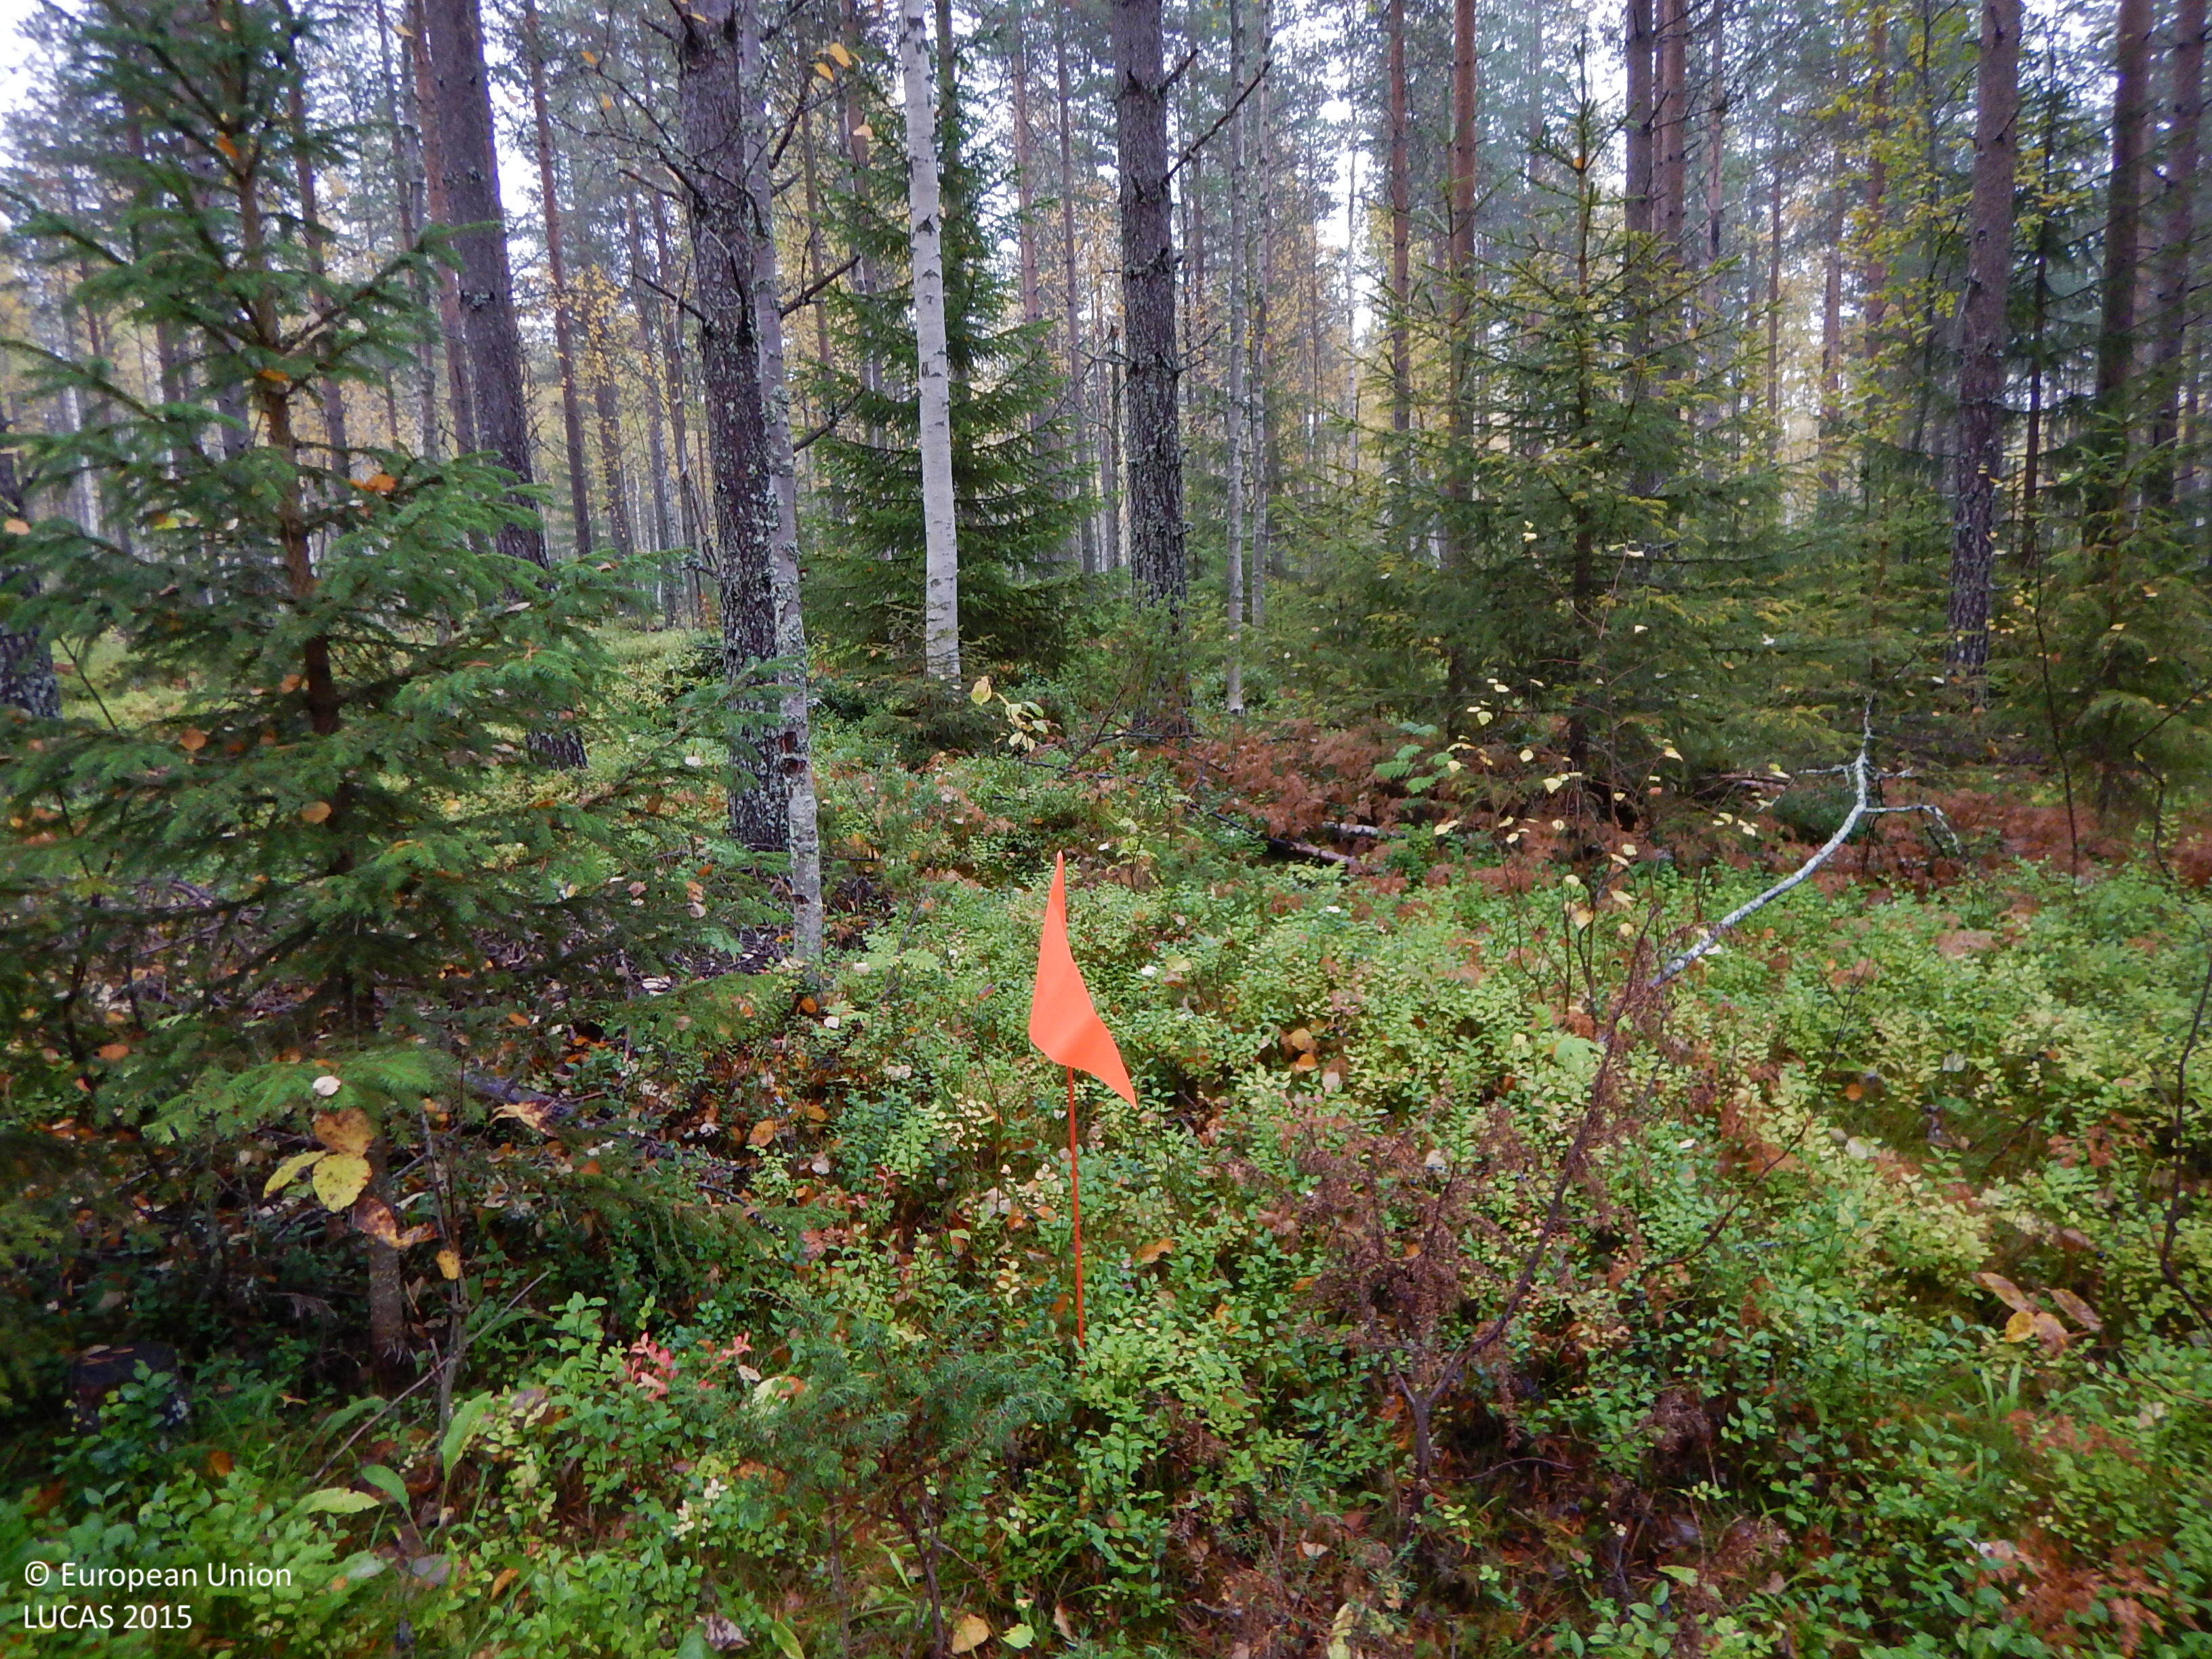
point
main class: Woodland
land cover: Pine dominated coniferous woodland
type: boreal forest
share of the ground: 50 - 75 %
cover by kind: coniferous forest trees 60 %, shrubs 15 %, herbaceous plants 10 %, lichens and mosses 10 %, broadleaved forest trees 5 %
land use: Forestry
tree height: > 5 m
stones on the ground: < 10 %
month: September
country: SE
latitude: 64.9753
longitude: 19.3952
